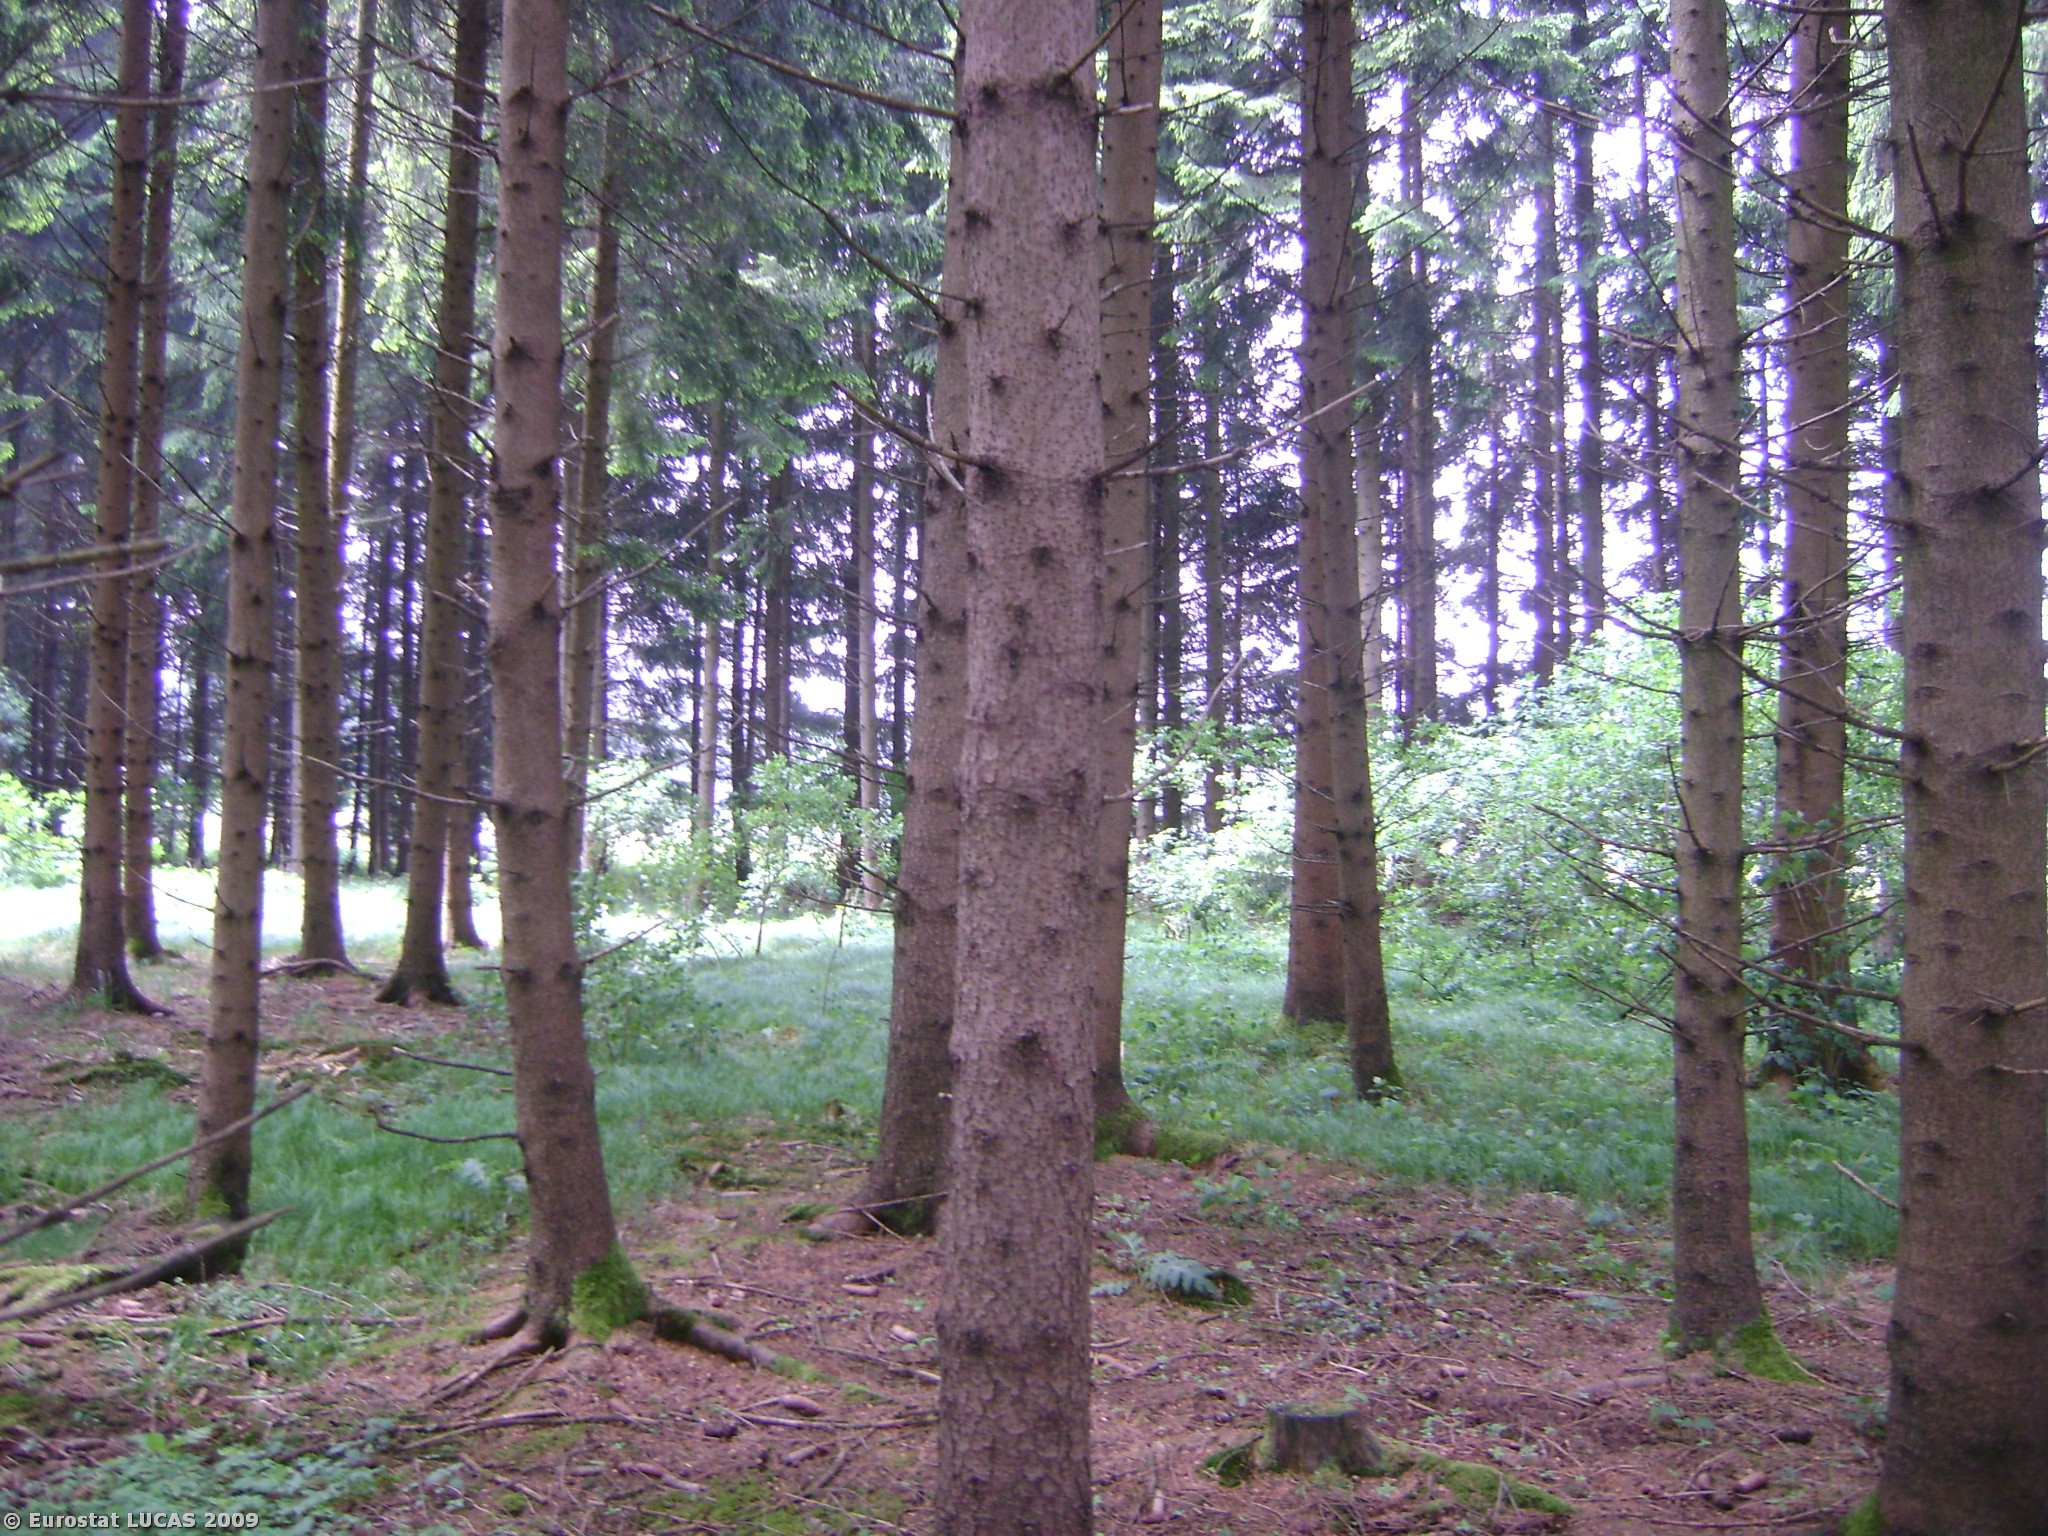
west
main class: Woodland
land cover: Coniferous woodland
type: hemiboreal forest and nemoral coniferous forest and mixed broadleaved-coniferous forest
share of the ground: > 75 %
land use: Forestry
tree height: > 5 m
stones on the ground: < 10 %
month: May
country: AT
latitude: 47.9782
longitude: 13.2275
